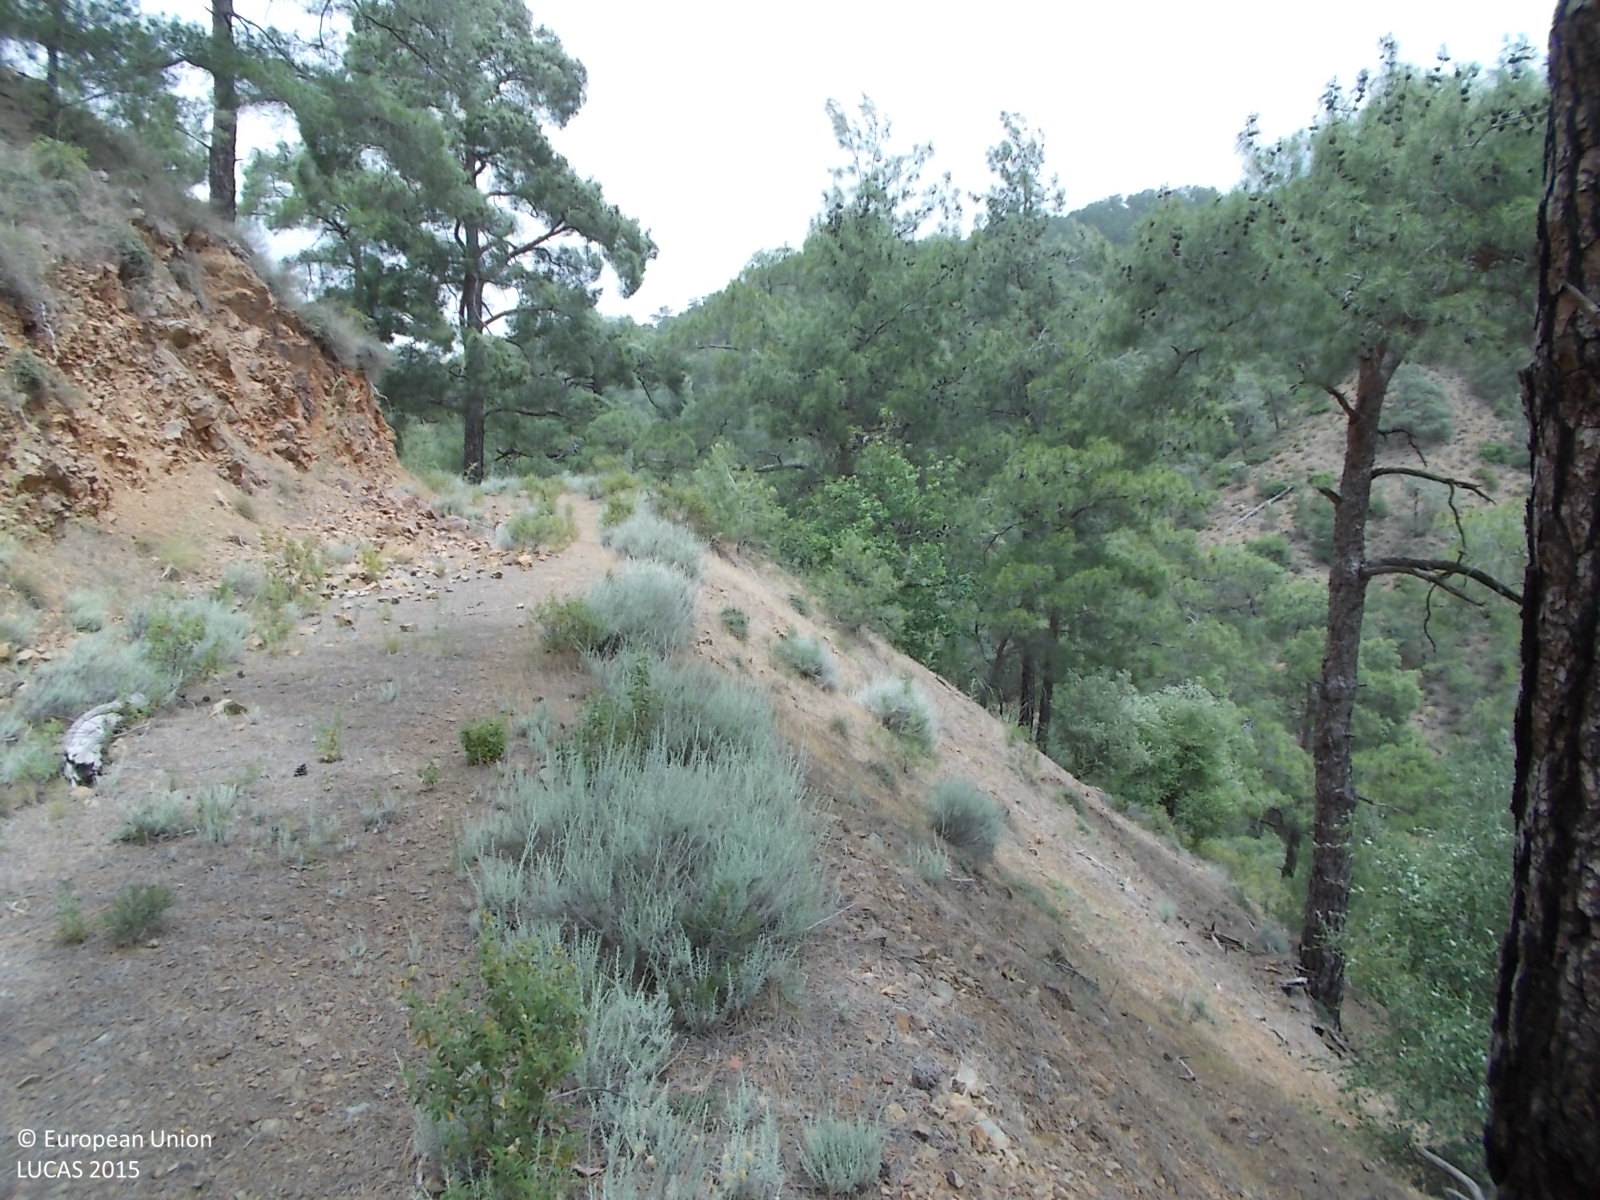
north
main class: Woodland
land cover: Pine dominated coniferous woodland
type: coniferous forest of the mediterranean region
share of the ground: > 75 %
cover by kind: coniferous forest trees 90 %, shrubs 10 %
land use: Semi-natural and natural areas not in use
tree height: > 5 m
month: May
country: CY
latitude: 34.9529
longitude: 32.5944
